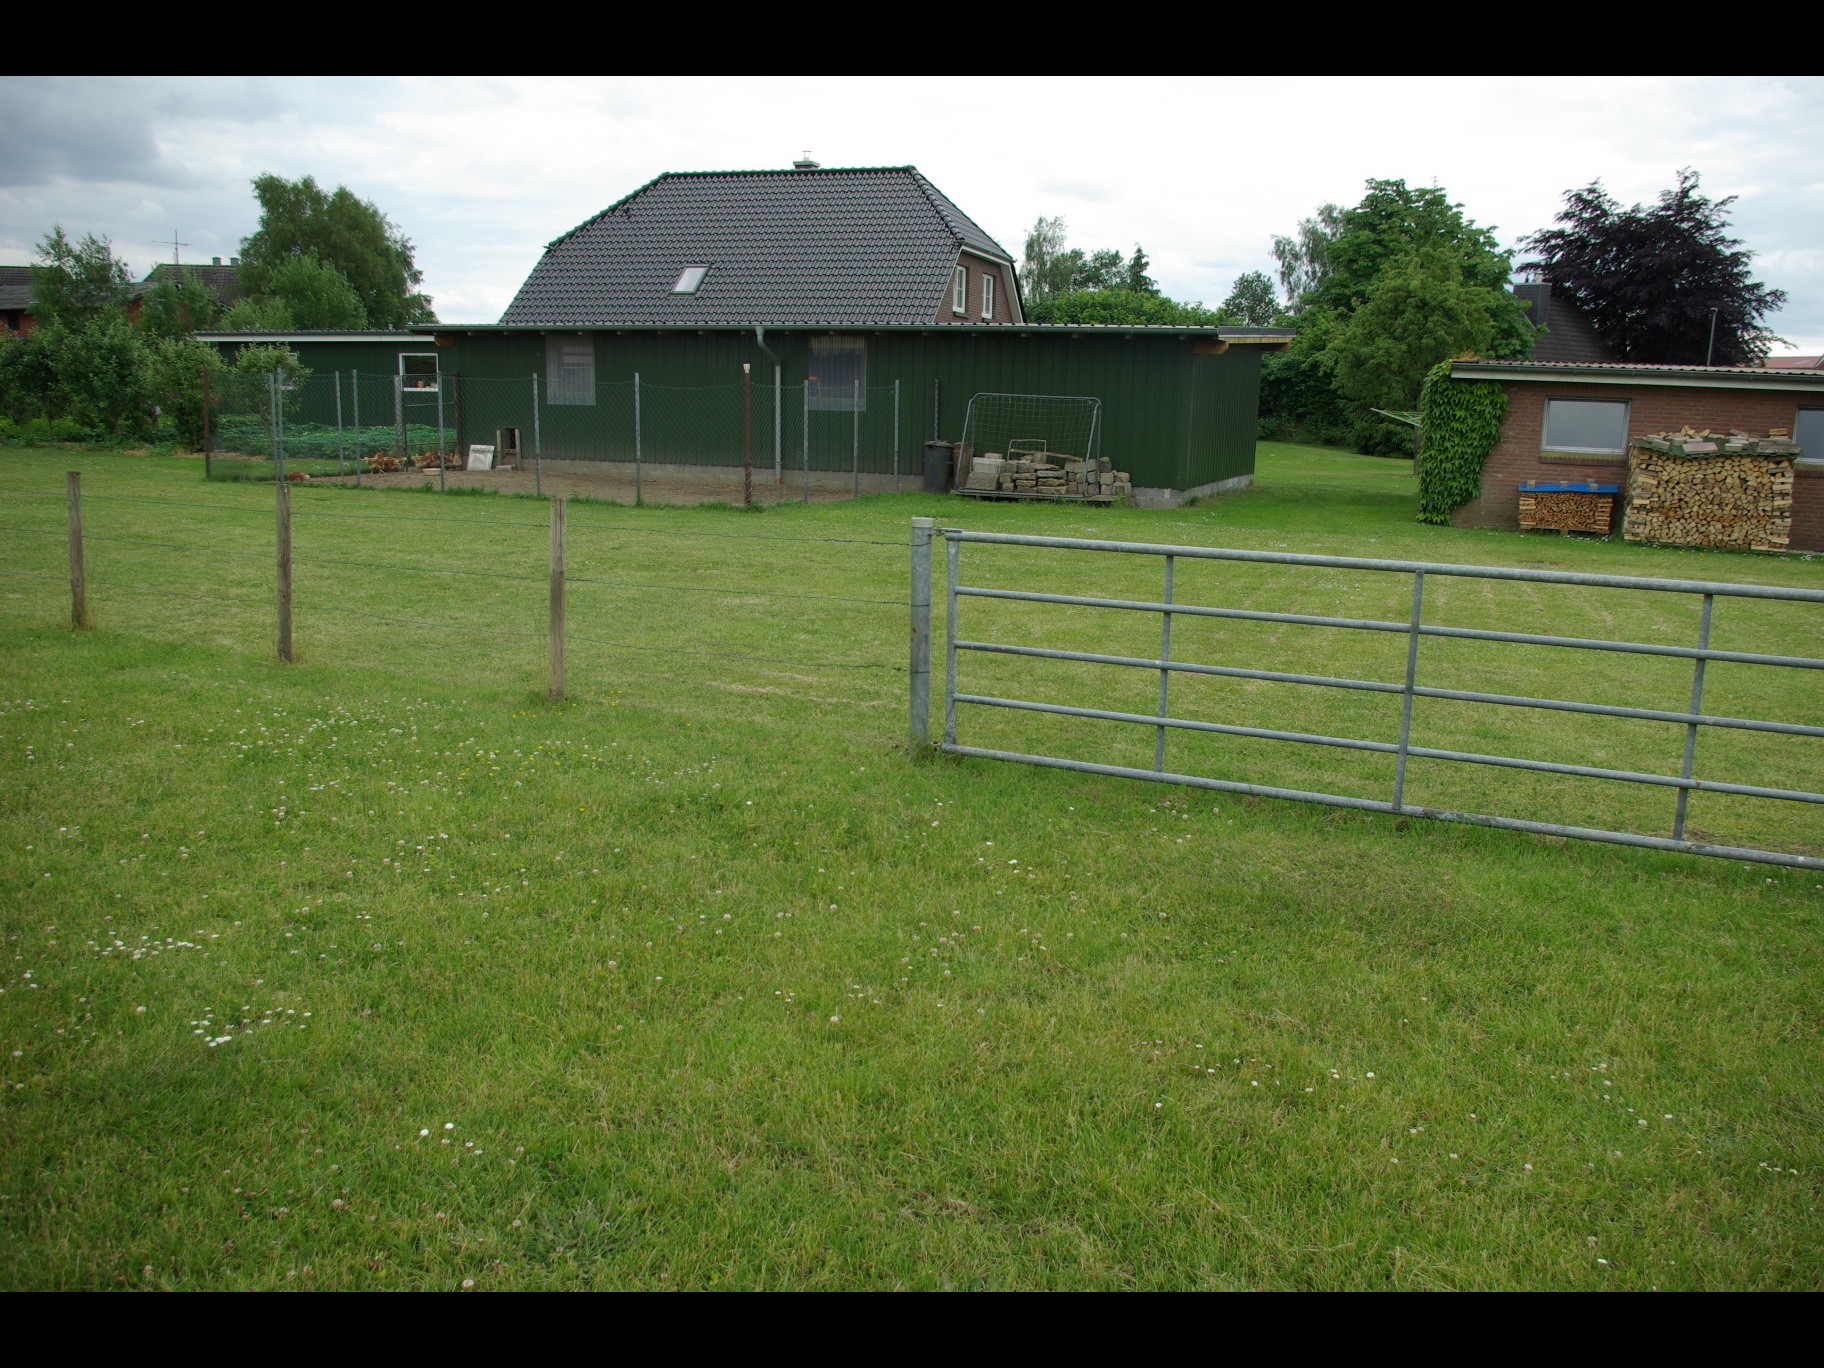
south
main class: Grassland
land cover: Grassland without tree/shrub cover
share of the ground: > 75 %
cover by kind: herbaceous plants 100 %
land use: Agriculture (excluding fallow land and kitchen gardens)
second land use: Amenities, museums, leisure
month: June
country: DE
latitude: 54.1387
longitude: 9.8929
